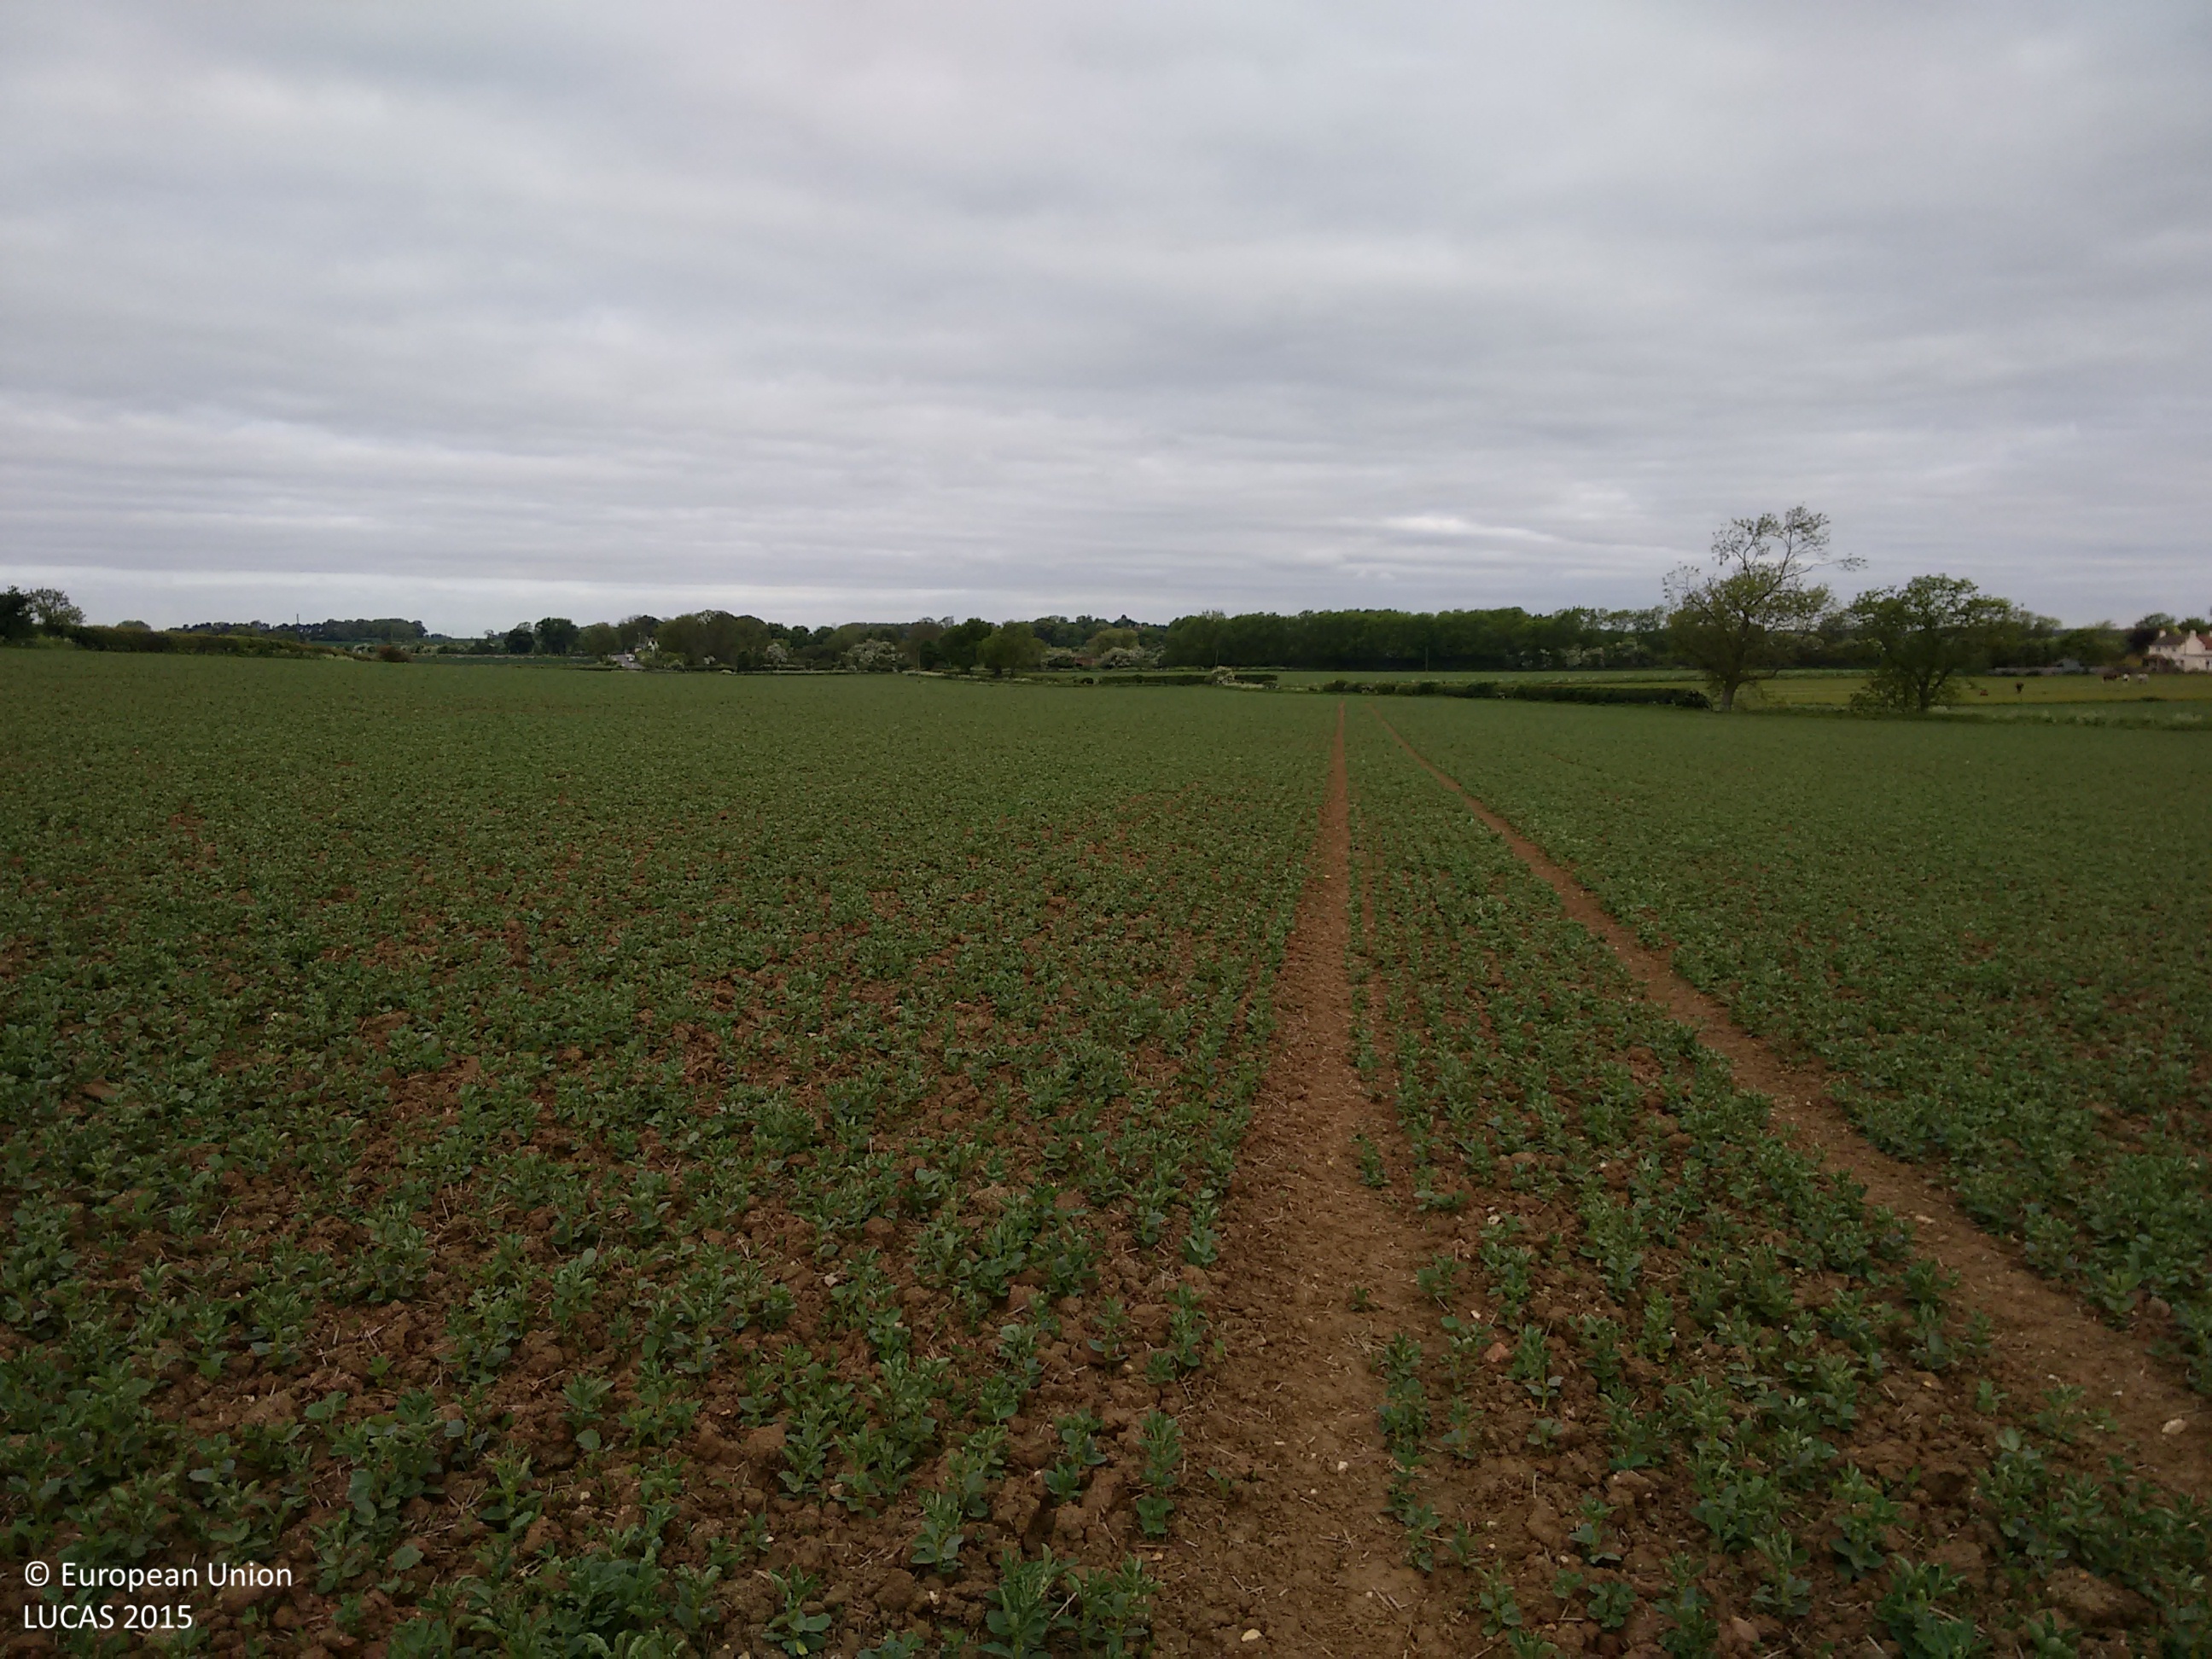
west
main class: Cropland
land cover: Dry pulses
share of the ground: 50 - 75 %
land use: Agriculture (excluding fallow land and kitchen gardens)
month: May
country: GB
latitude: 53.4590
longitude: -0.6266
